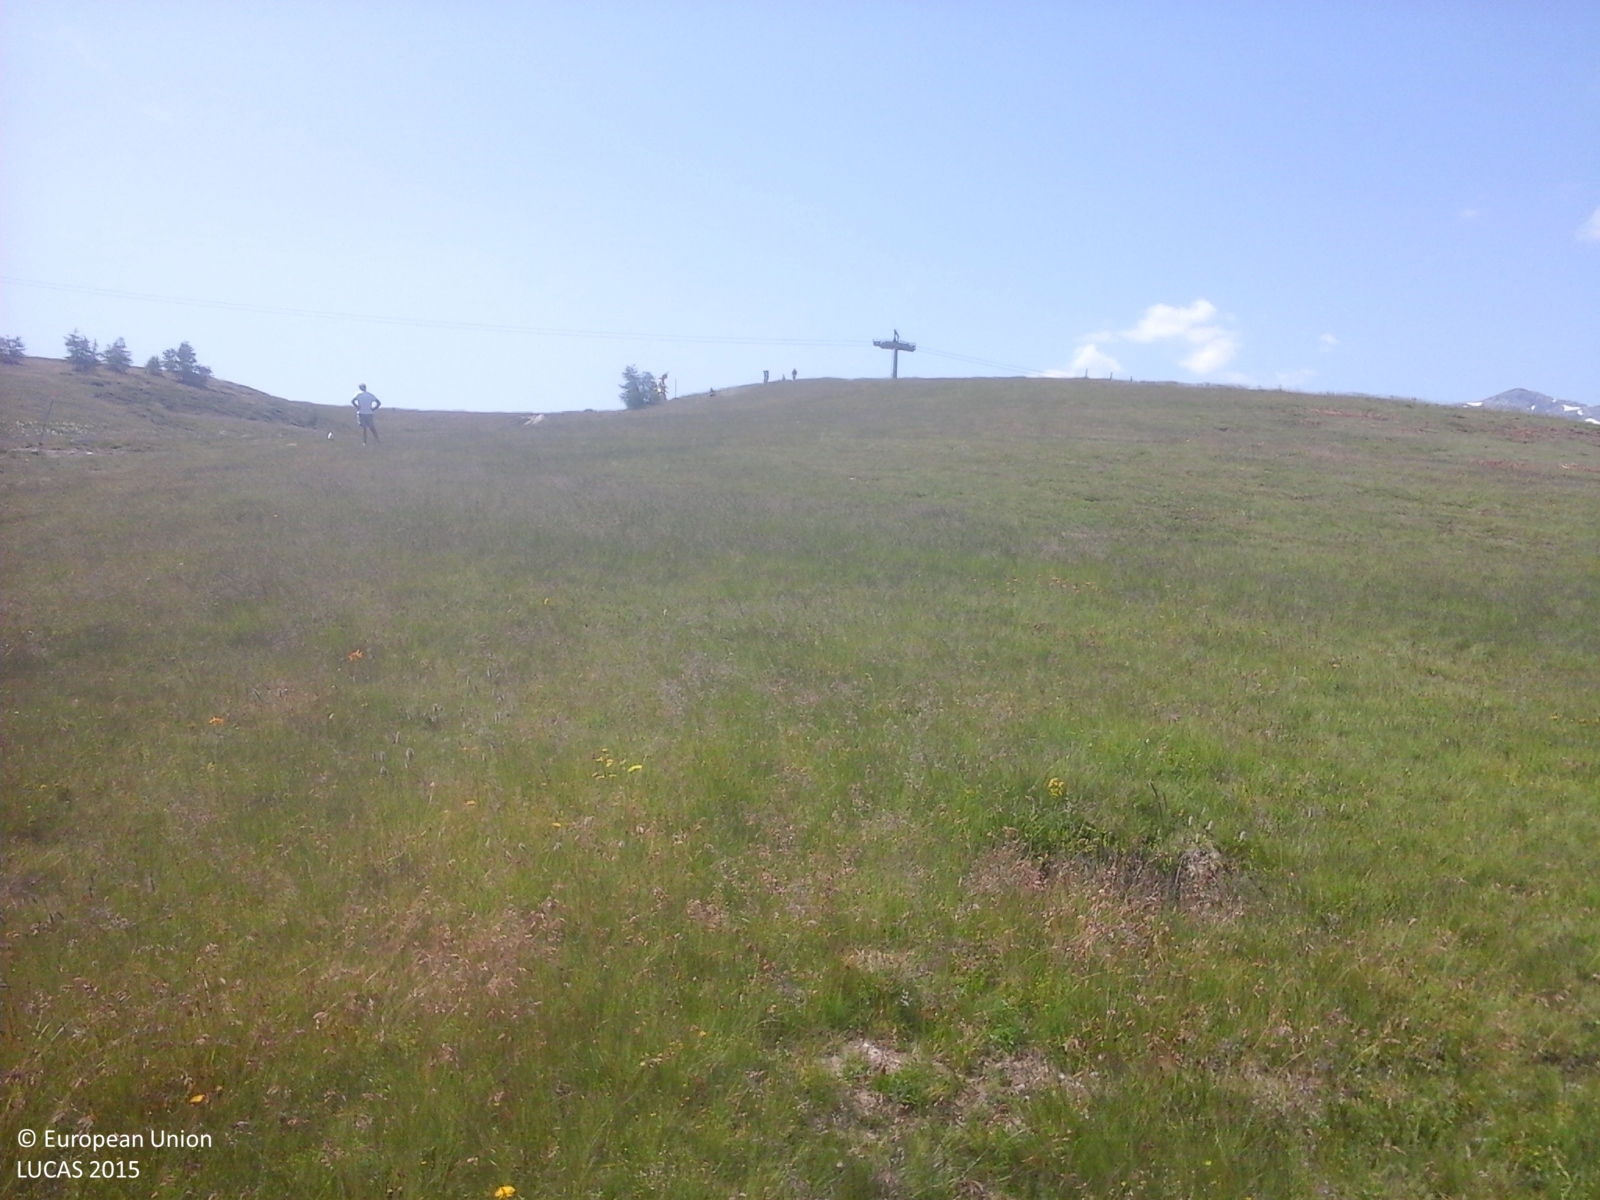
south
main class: Grassland
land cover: Grassland without tree/shrub cover
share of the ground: > 75 %
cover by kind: herbaceous plants 100 %
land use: Agriculture (excluding fallow land and kitchen gardens)
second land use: Sport
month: July
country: IT
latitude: 46.4213
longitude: 9.3633
